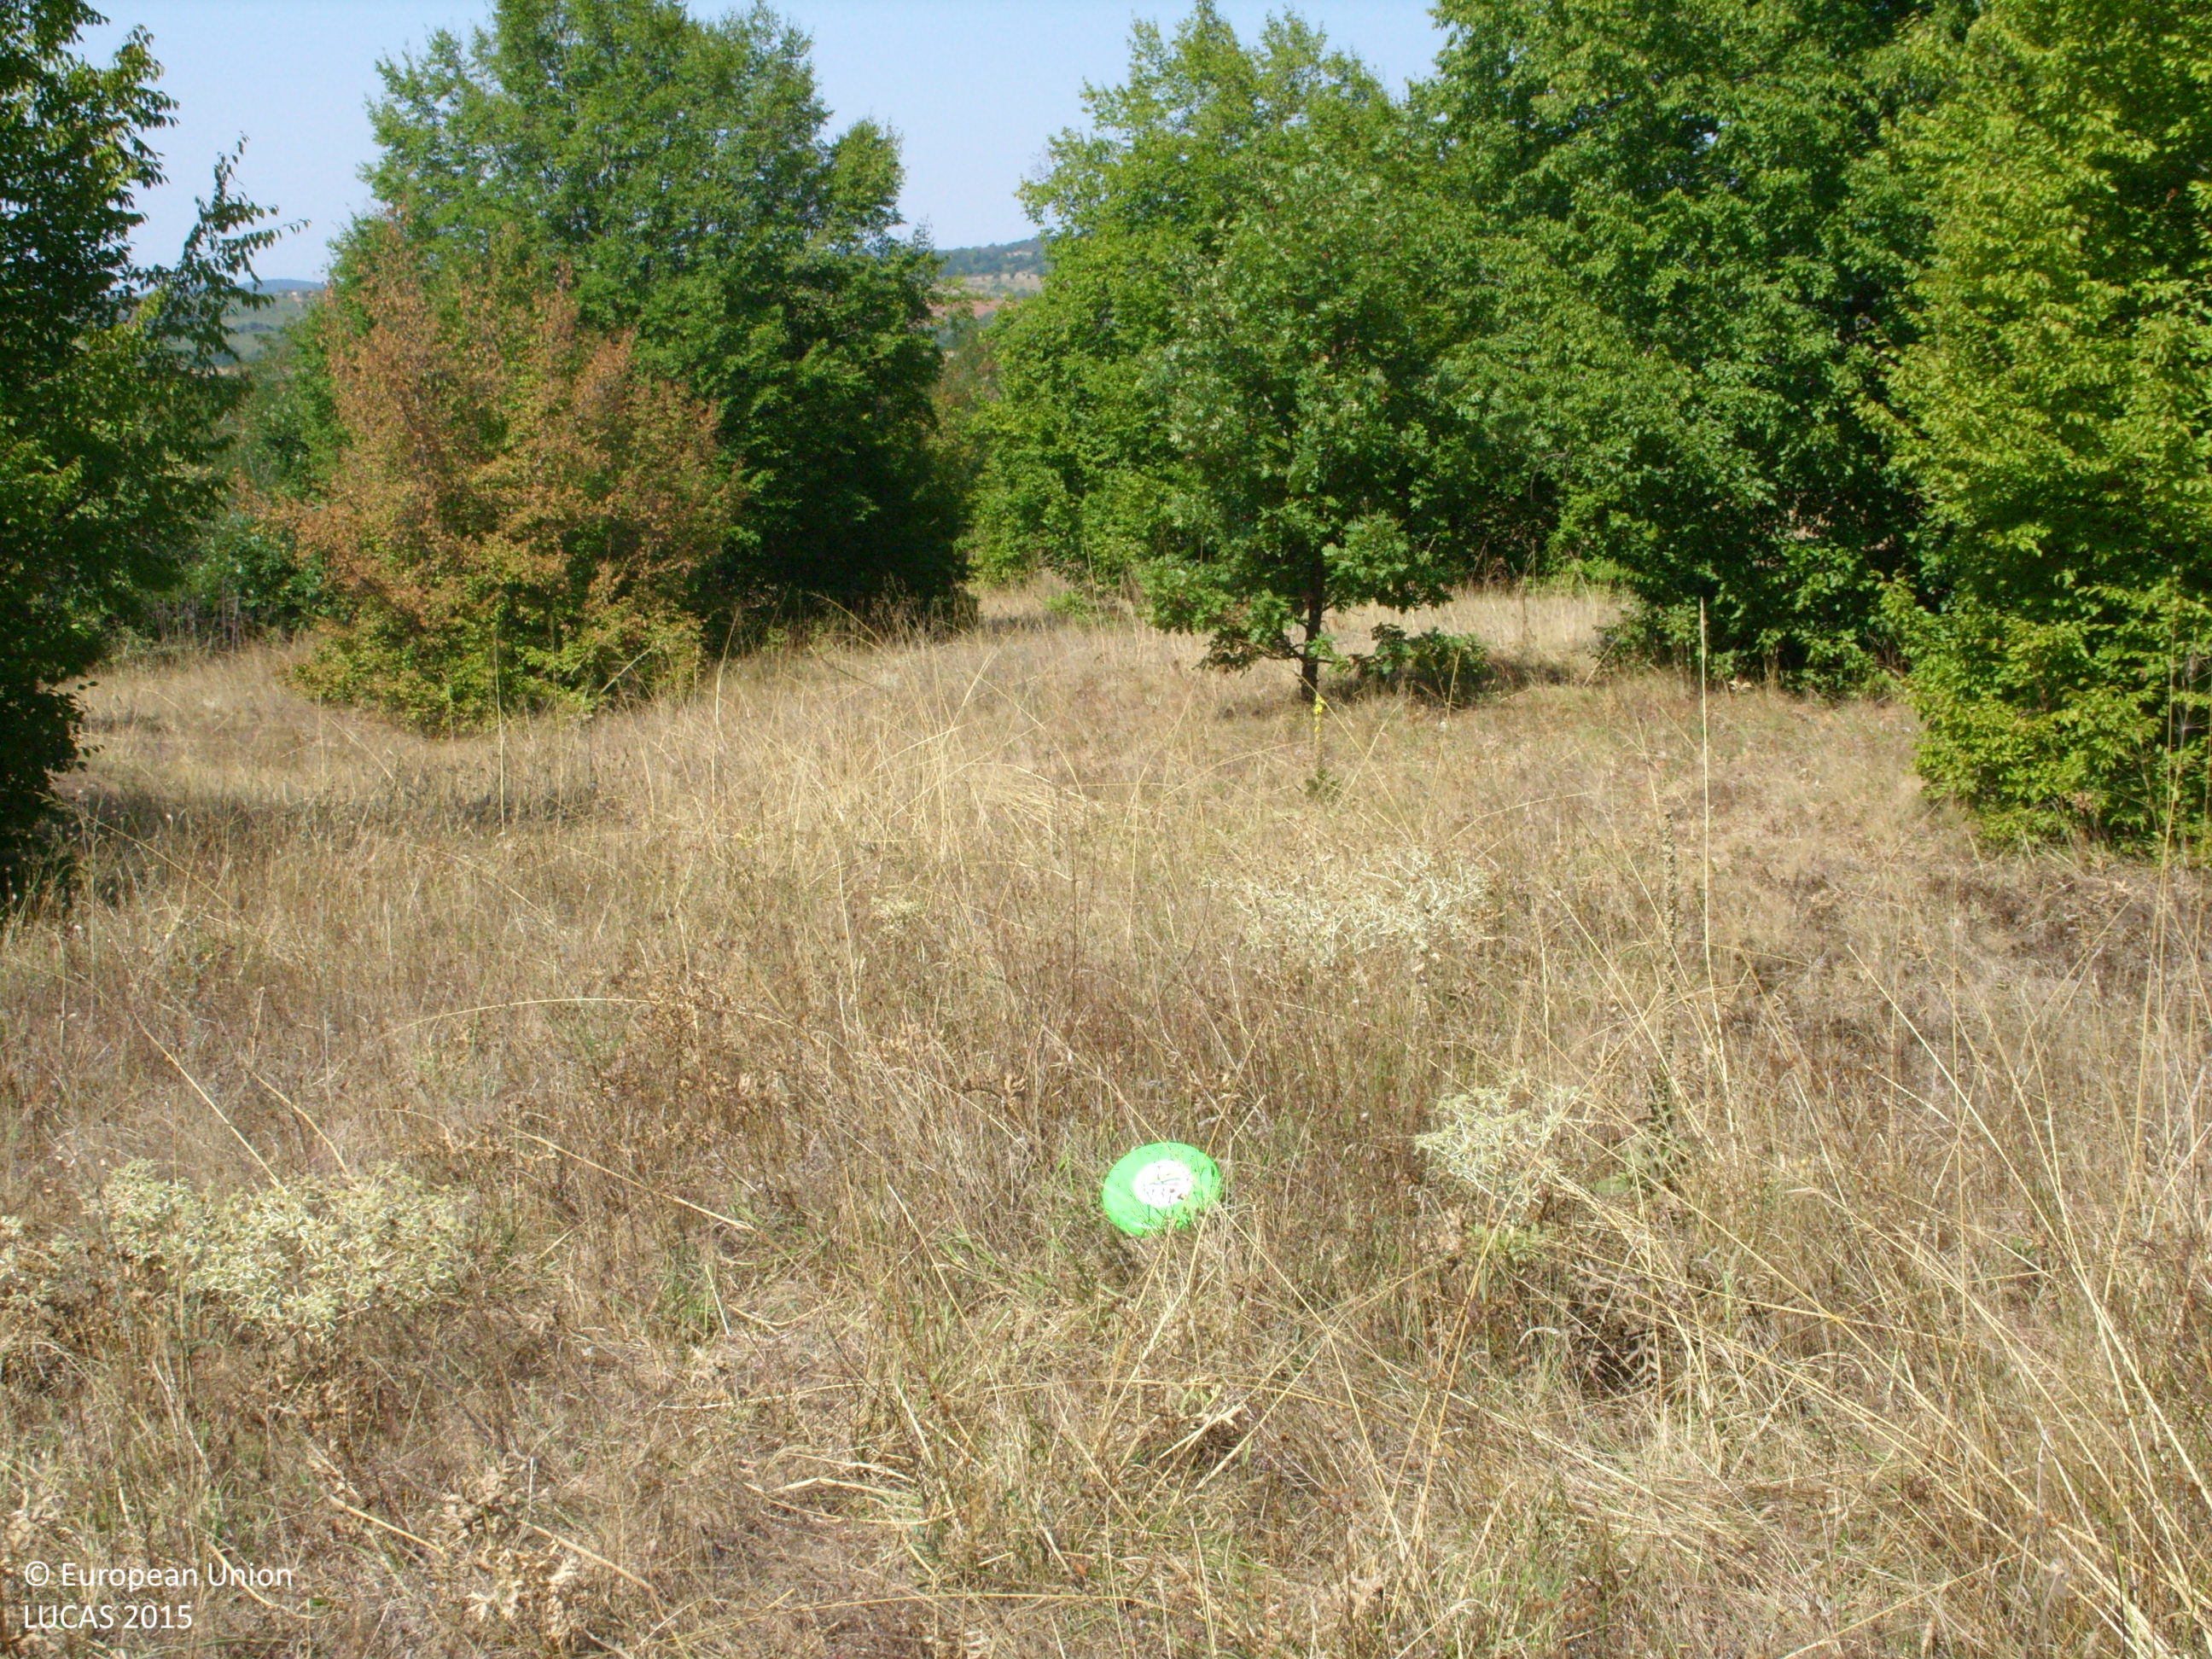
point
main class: Grassland
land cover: Grassland with sparse tree/shrub cover
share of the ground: > 75 %
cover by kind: herbaceous plants 85 %, shrubs 10 %, broadleaved forest trees 5 %
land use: Semi-natural and natural areas not in use
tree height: < 5 m
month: August
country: BG
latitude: 42.4142
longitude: 25.0929
